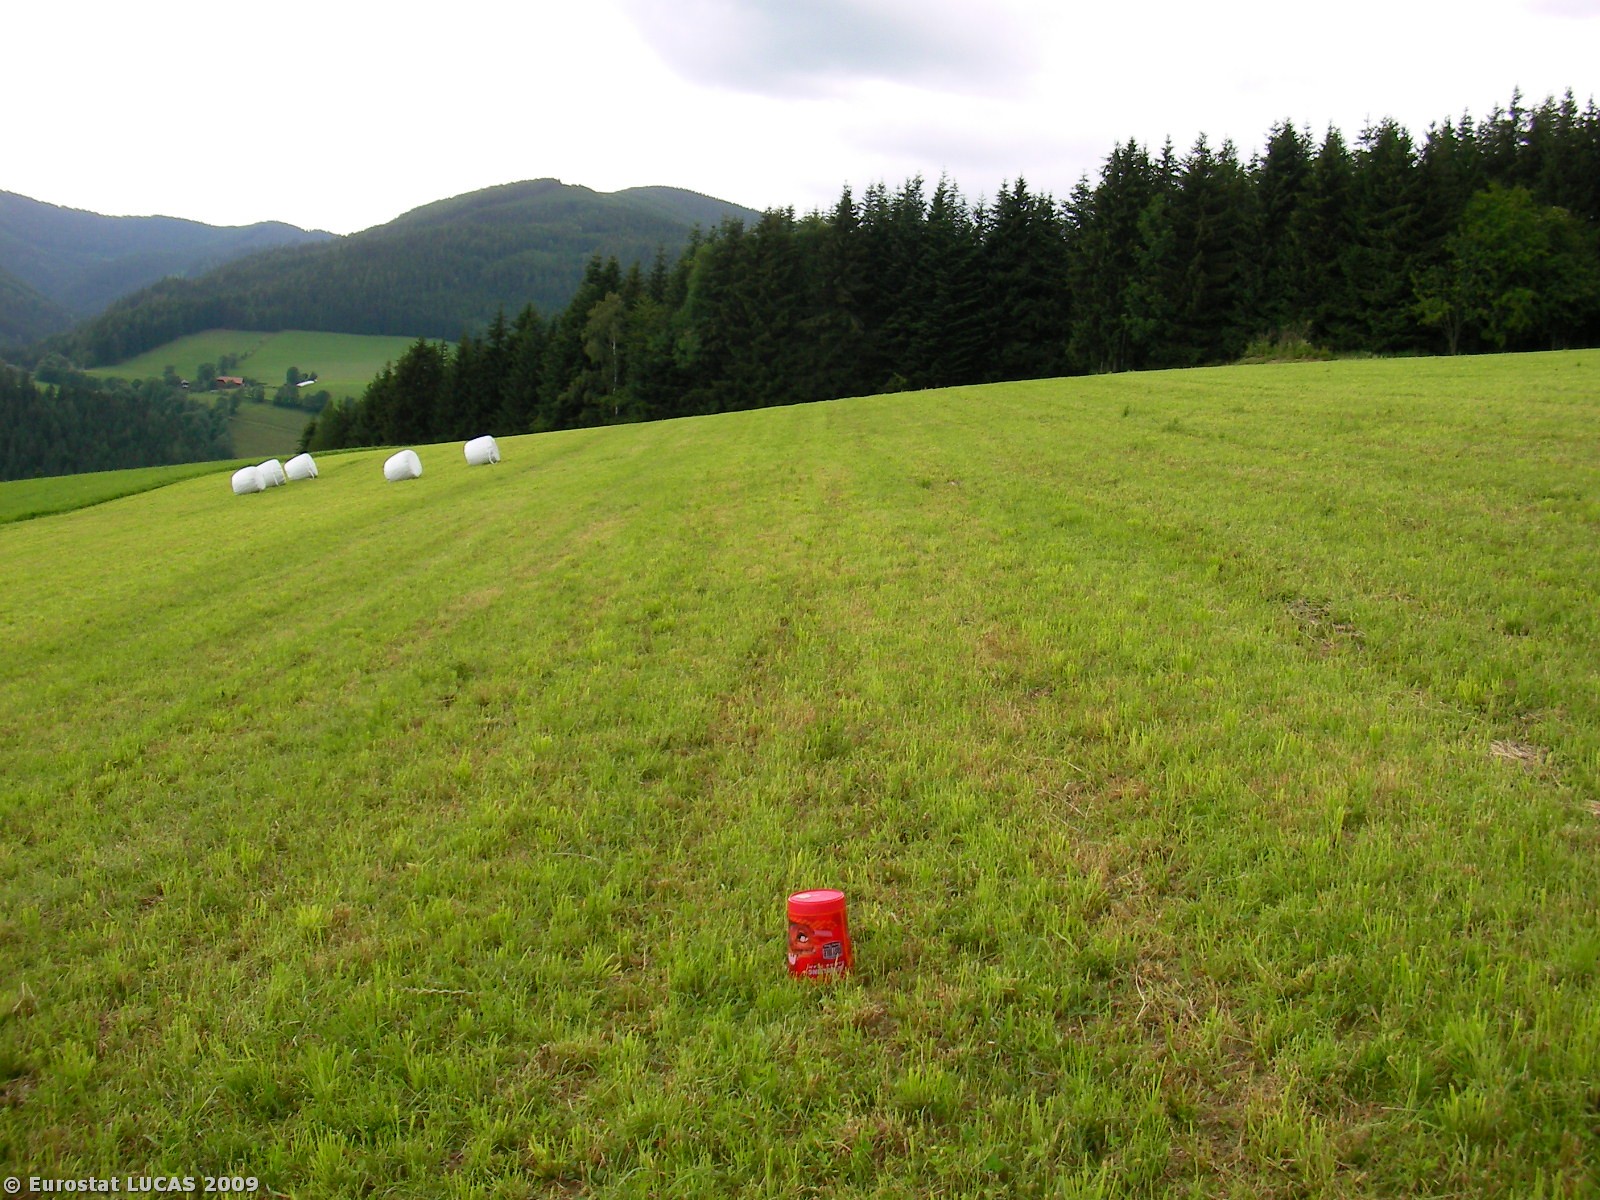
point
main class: Grassland
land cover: Grassland without tree/shrub cover
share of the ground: > 75 %
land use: Agriculture (excluding fallow land and kitchen gardens)
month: July
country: AT
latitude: 47.4299
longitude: 15.6356
